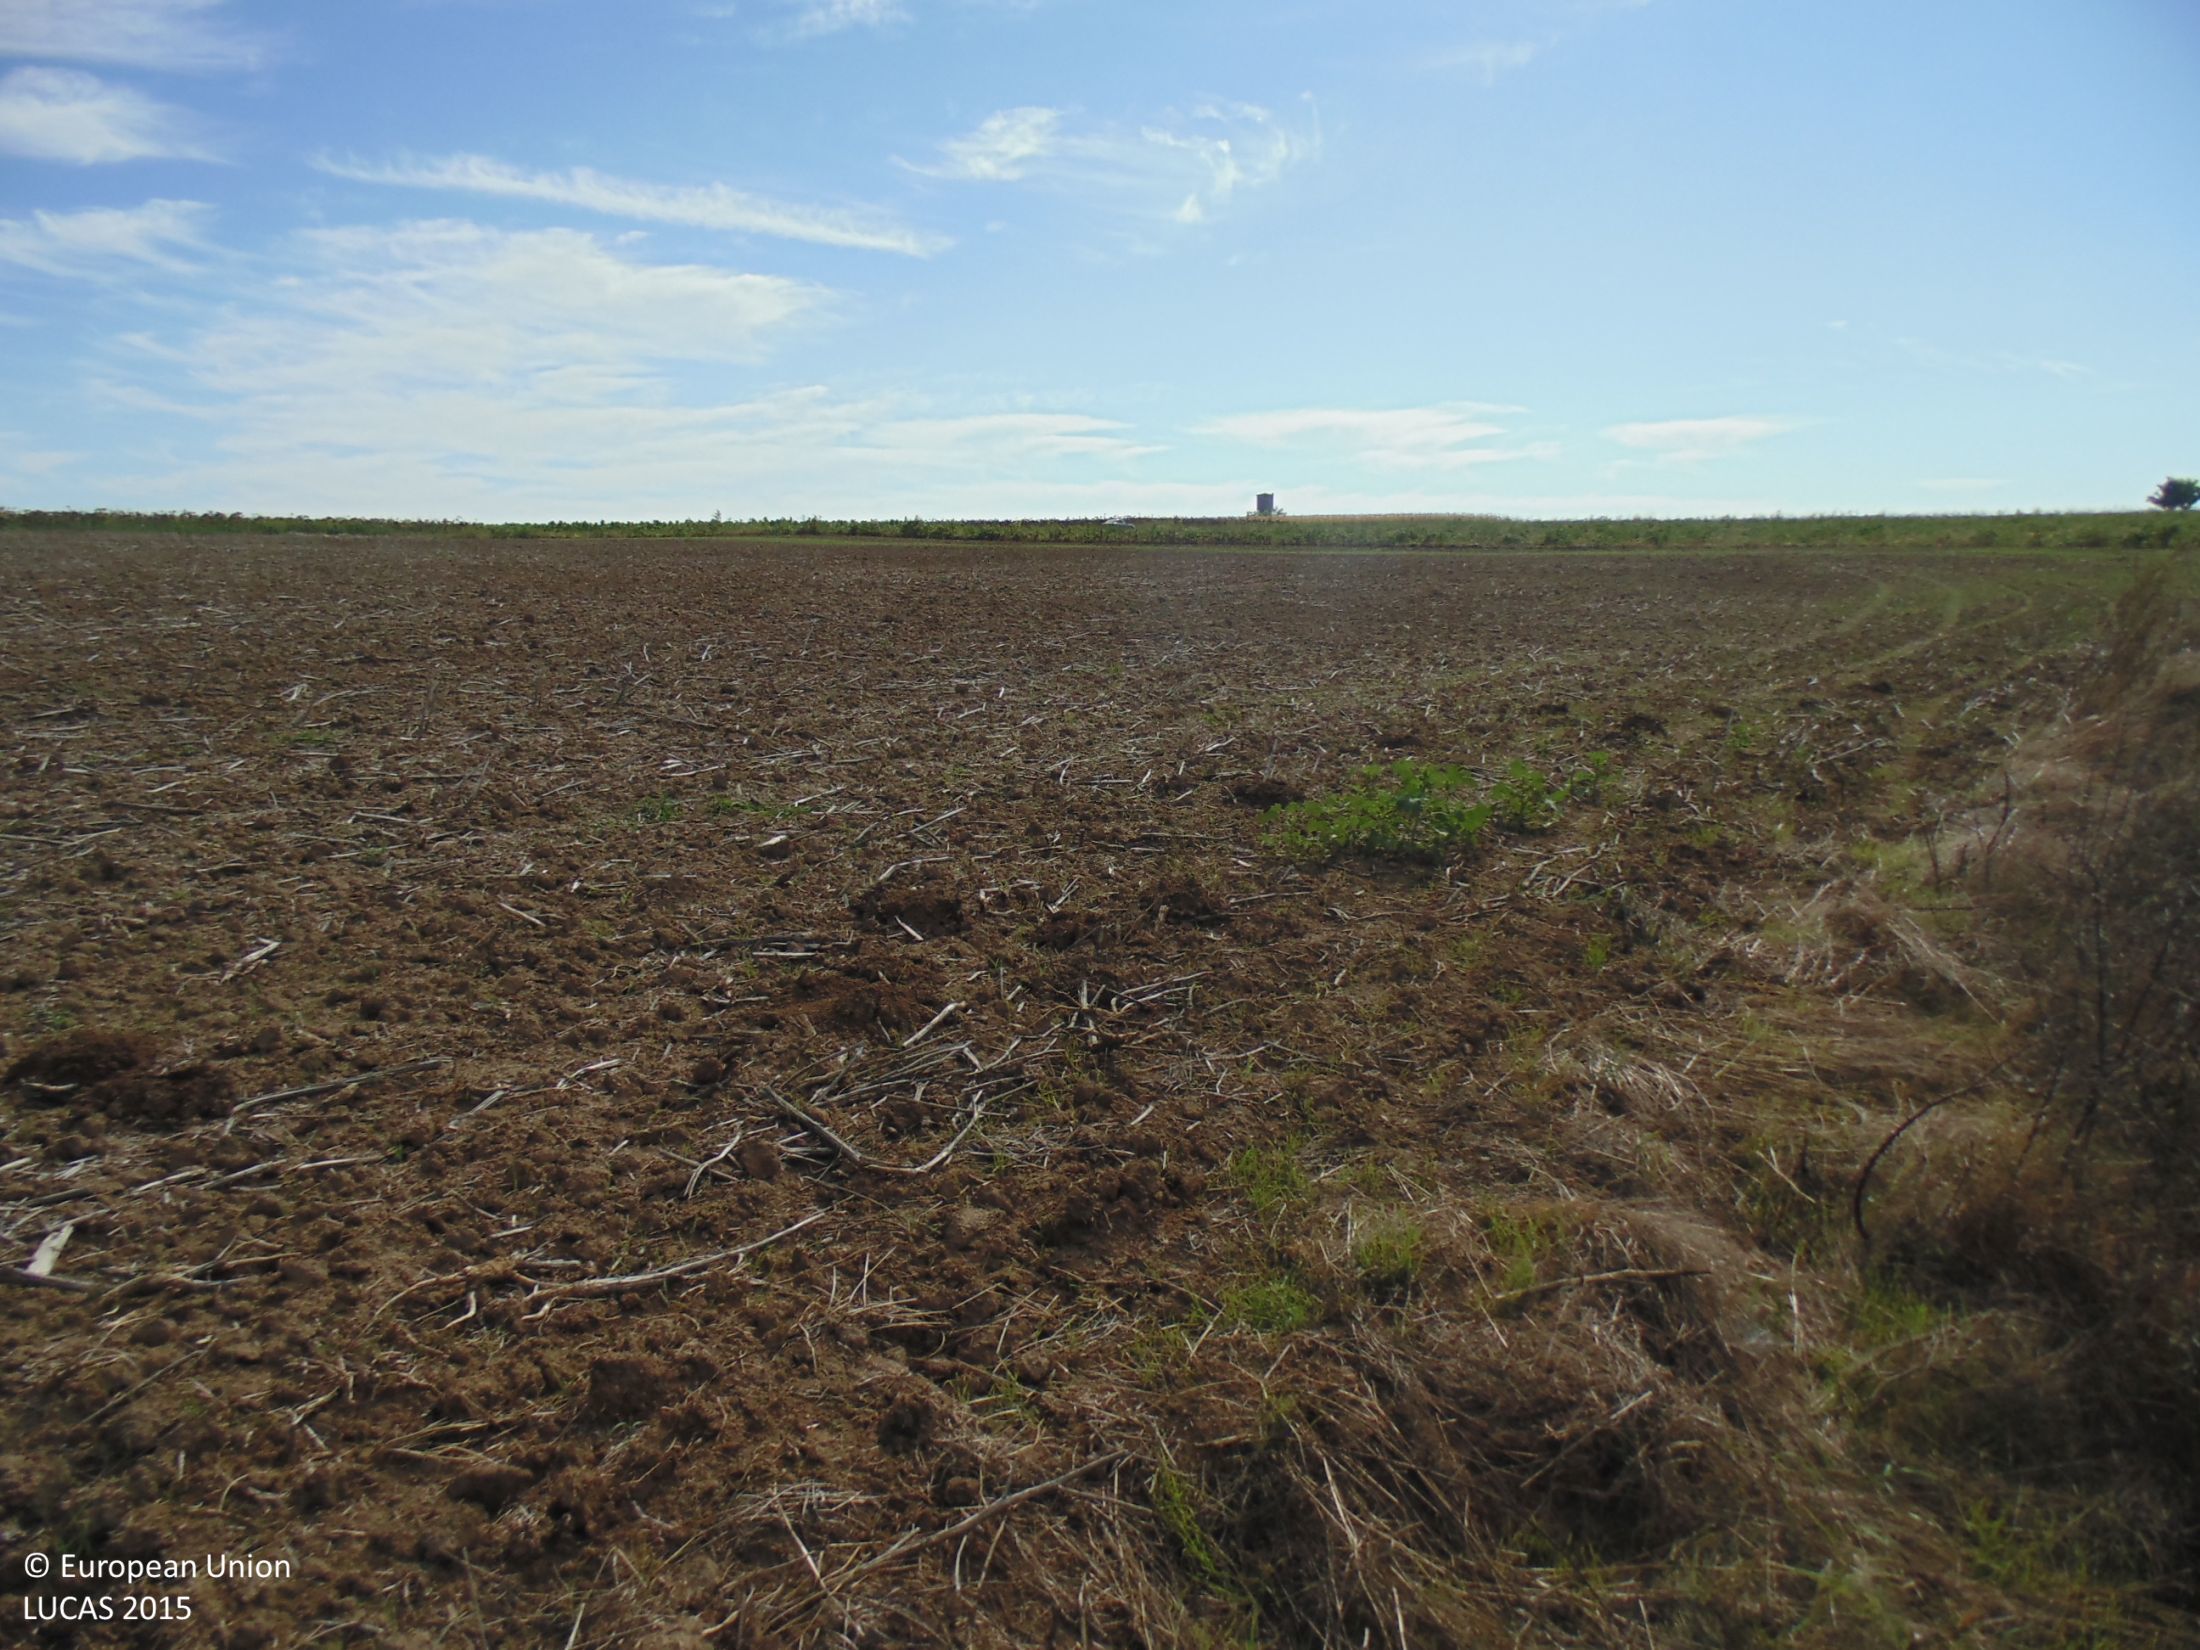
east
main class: Grassland
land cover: Grassland with sparse tree/shrub cover
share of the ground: > 75 %
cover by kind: herbaceous plants 90 %, broadleaved forest trees 5 %, shrubs 5 %
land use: Semi-natural and natural areas not in use
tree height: < 5 m
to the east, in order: Grassland with sparse tree/shrub cover; Rape and turnip rape; Grass margins; Other fresh vegetables; Grass margins; Tracks; Grass margins; Other fresh vegetables; Grass margins; Tobacco; Grass margins; Other fresh vegetables; Grass margins; Sunflower
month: September
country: BG
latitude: 43.8518
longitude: 27.1305
